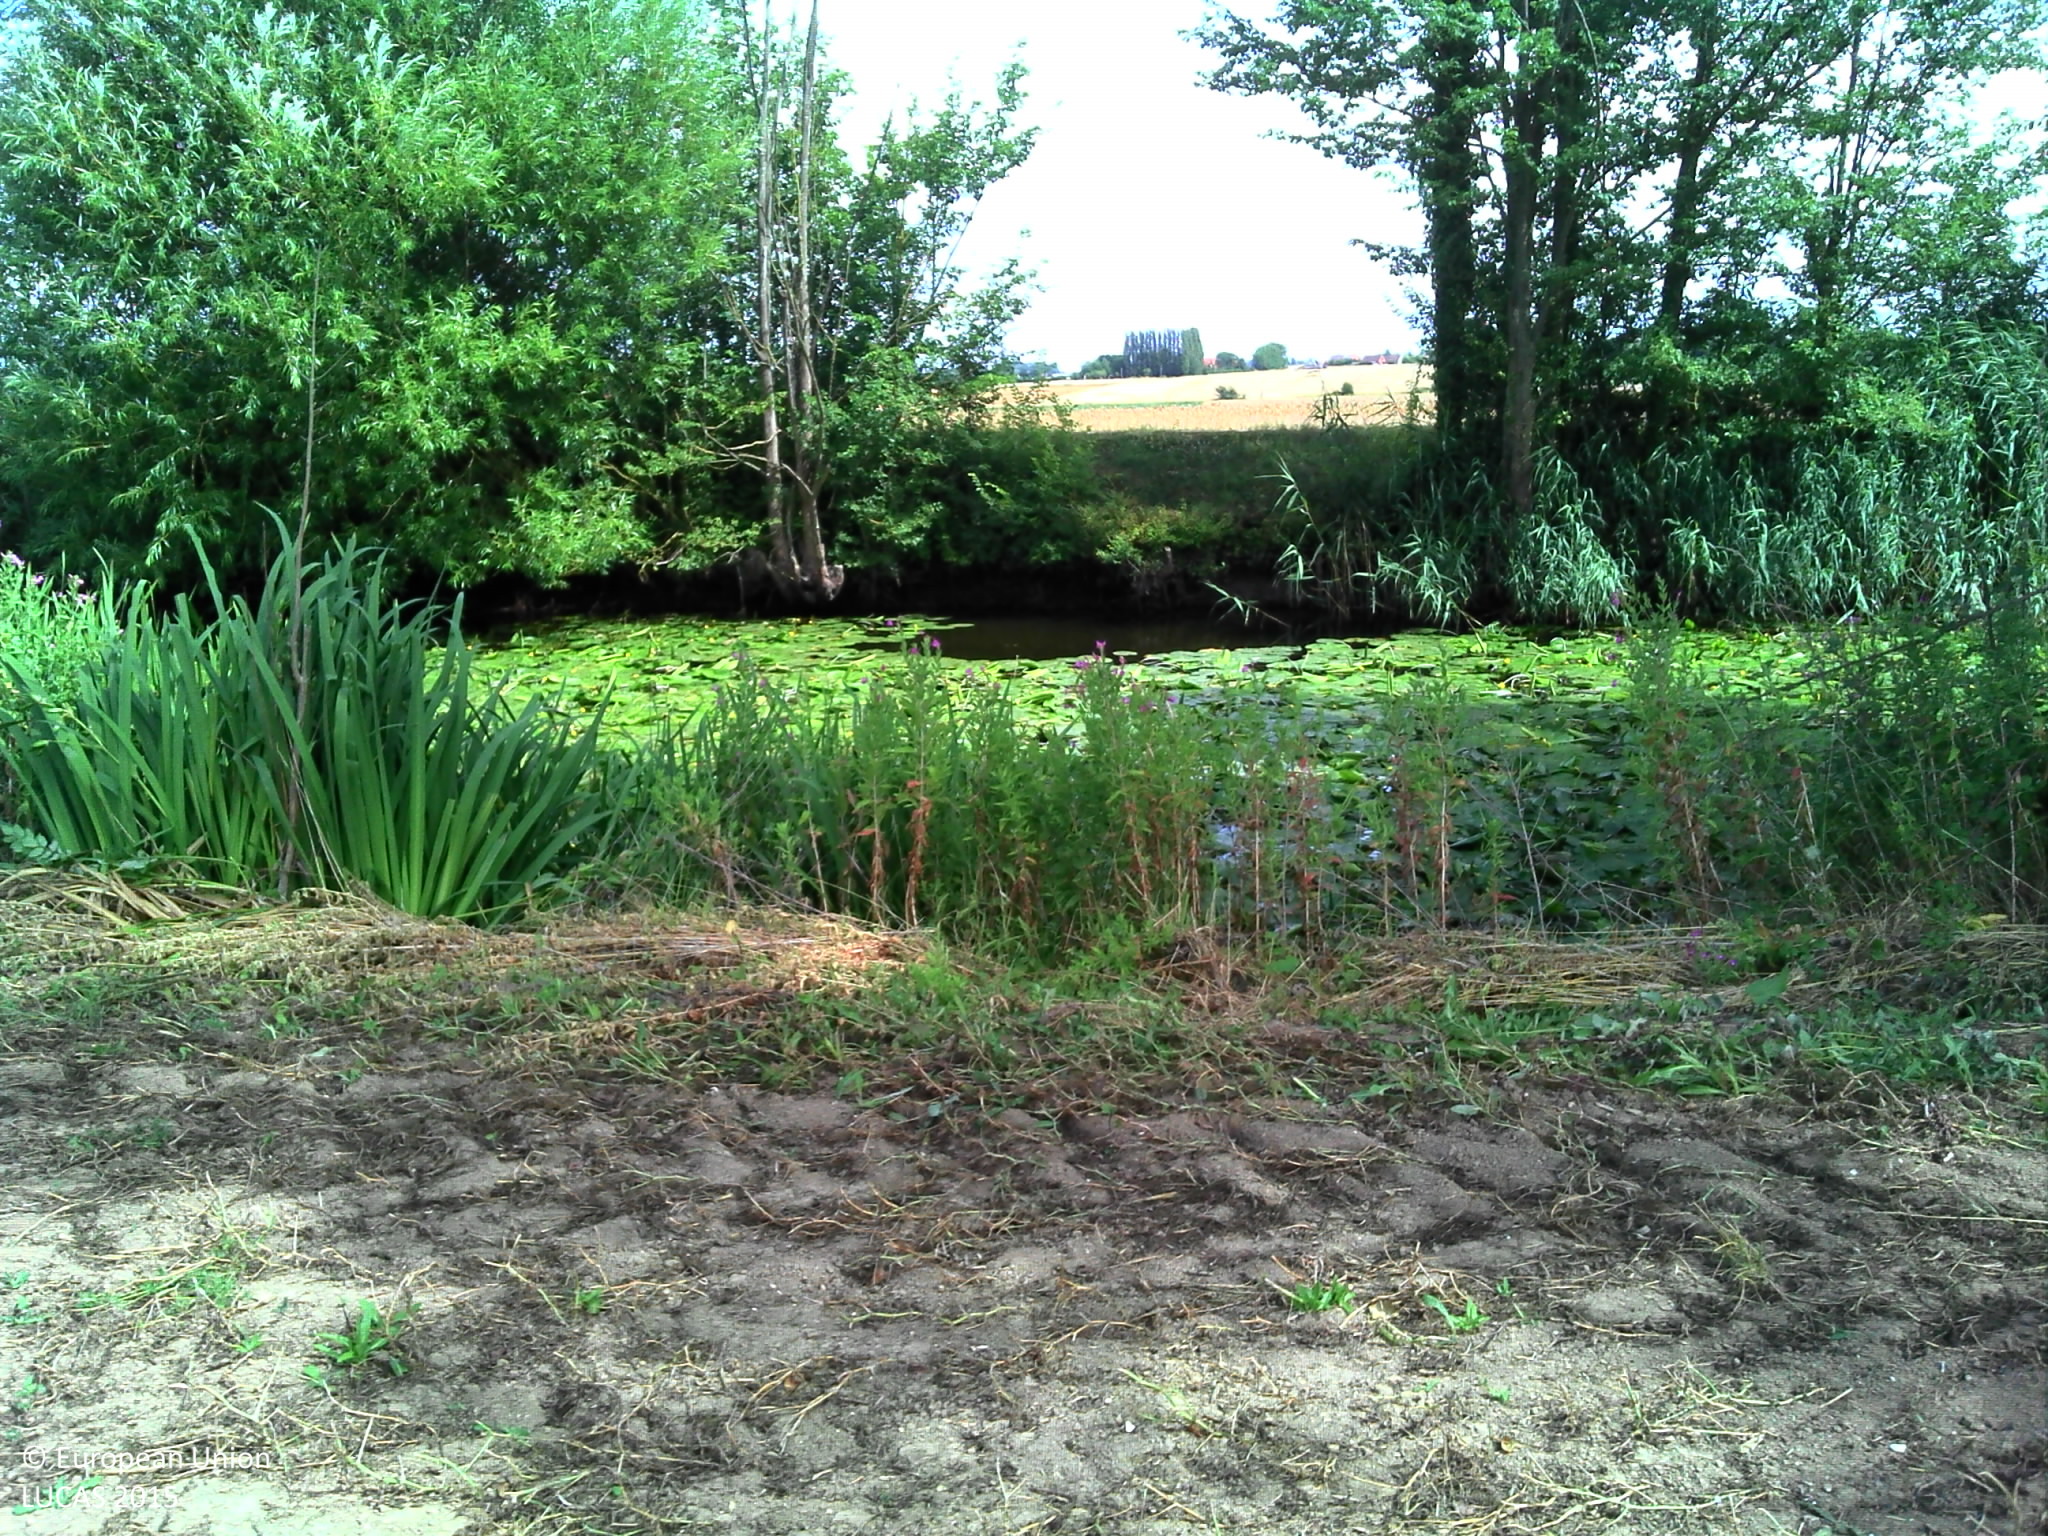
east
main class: Cropland
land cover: Dry pulses
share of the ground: < 10 %
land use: Agriculture (excluding fallow land and kitchen gardens)
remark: Harvested field
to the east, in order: Dry pulses; Inland fresh running water; Abandoned hedges; Spontaneously vegetated surfaces; Grass margins; Tracks; Grass margins; Dry pulses
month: July
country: FR
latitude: 50.7971
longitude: 2.3962
